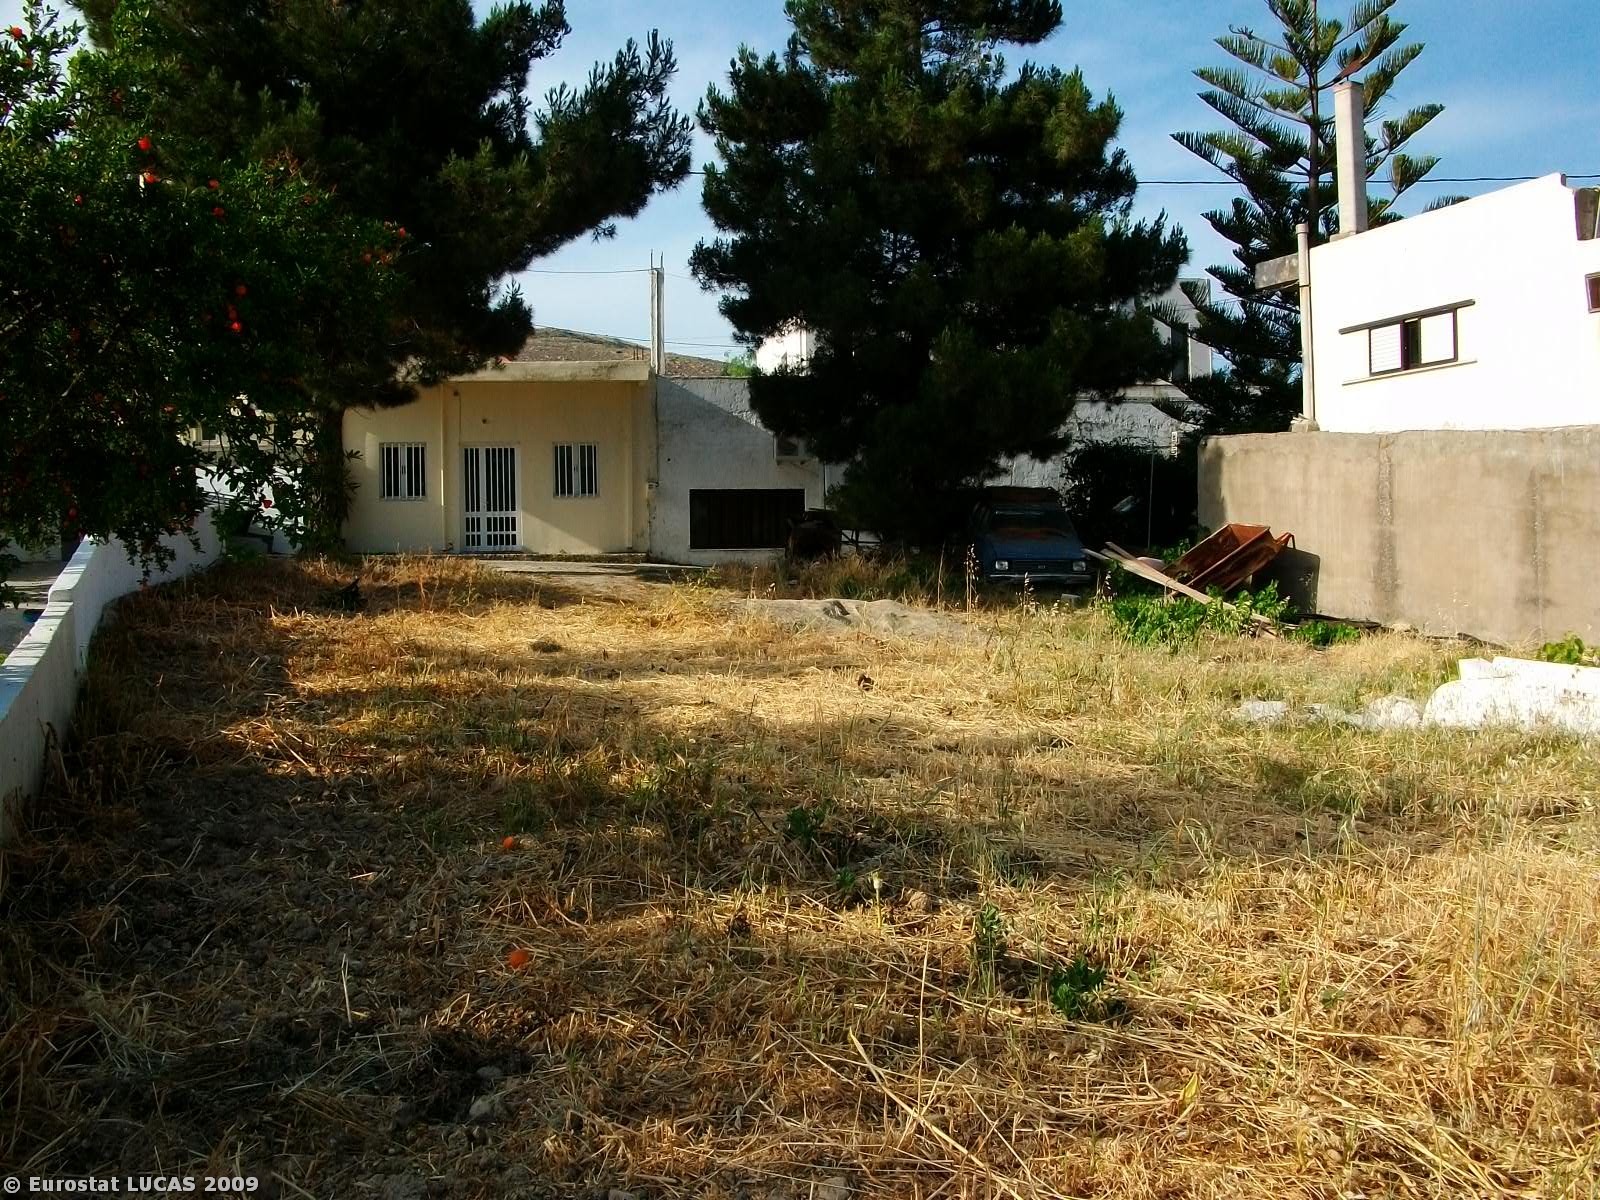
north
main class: Cropland
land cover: Vineyards
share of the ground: > 75 %
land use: Agriculture (excluding fallow land and kitchen gardens)
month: June
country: GR
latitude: 35.0586
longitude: 25.1075
